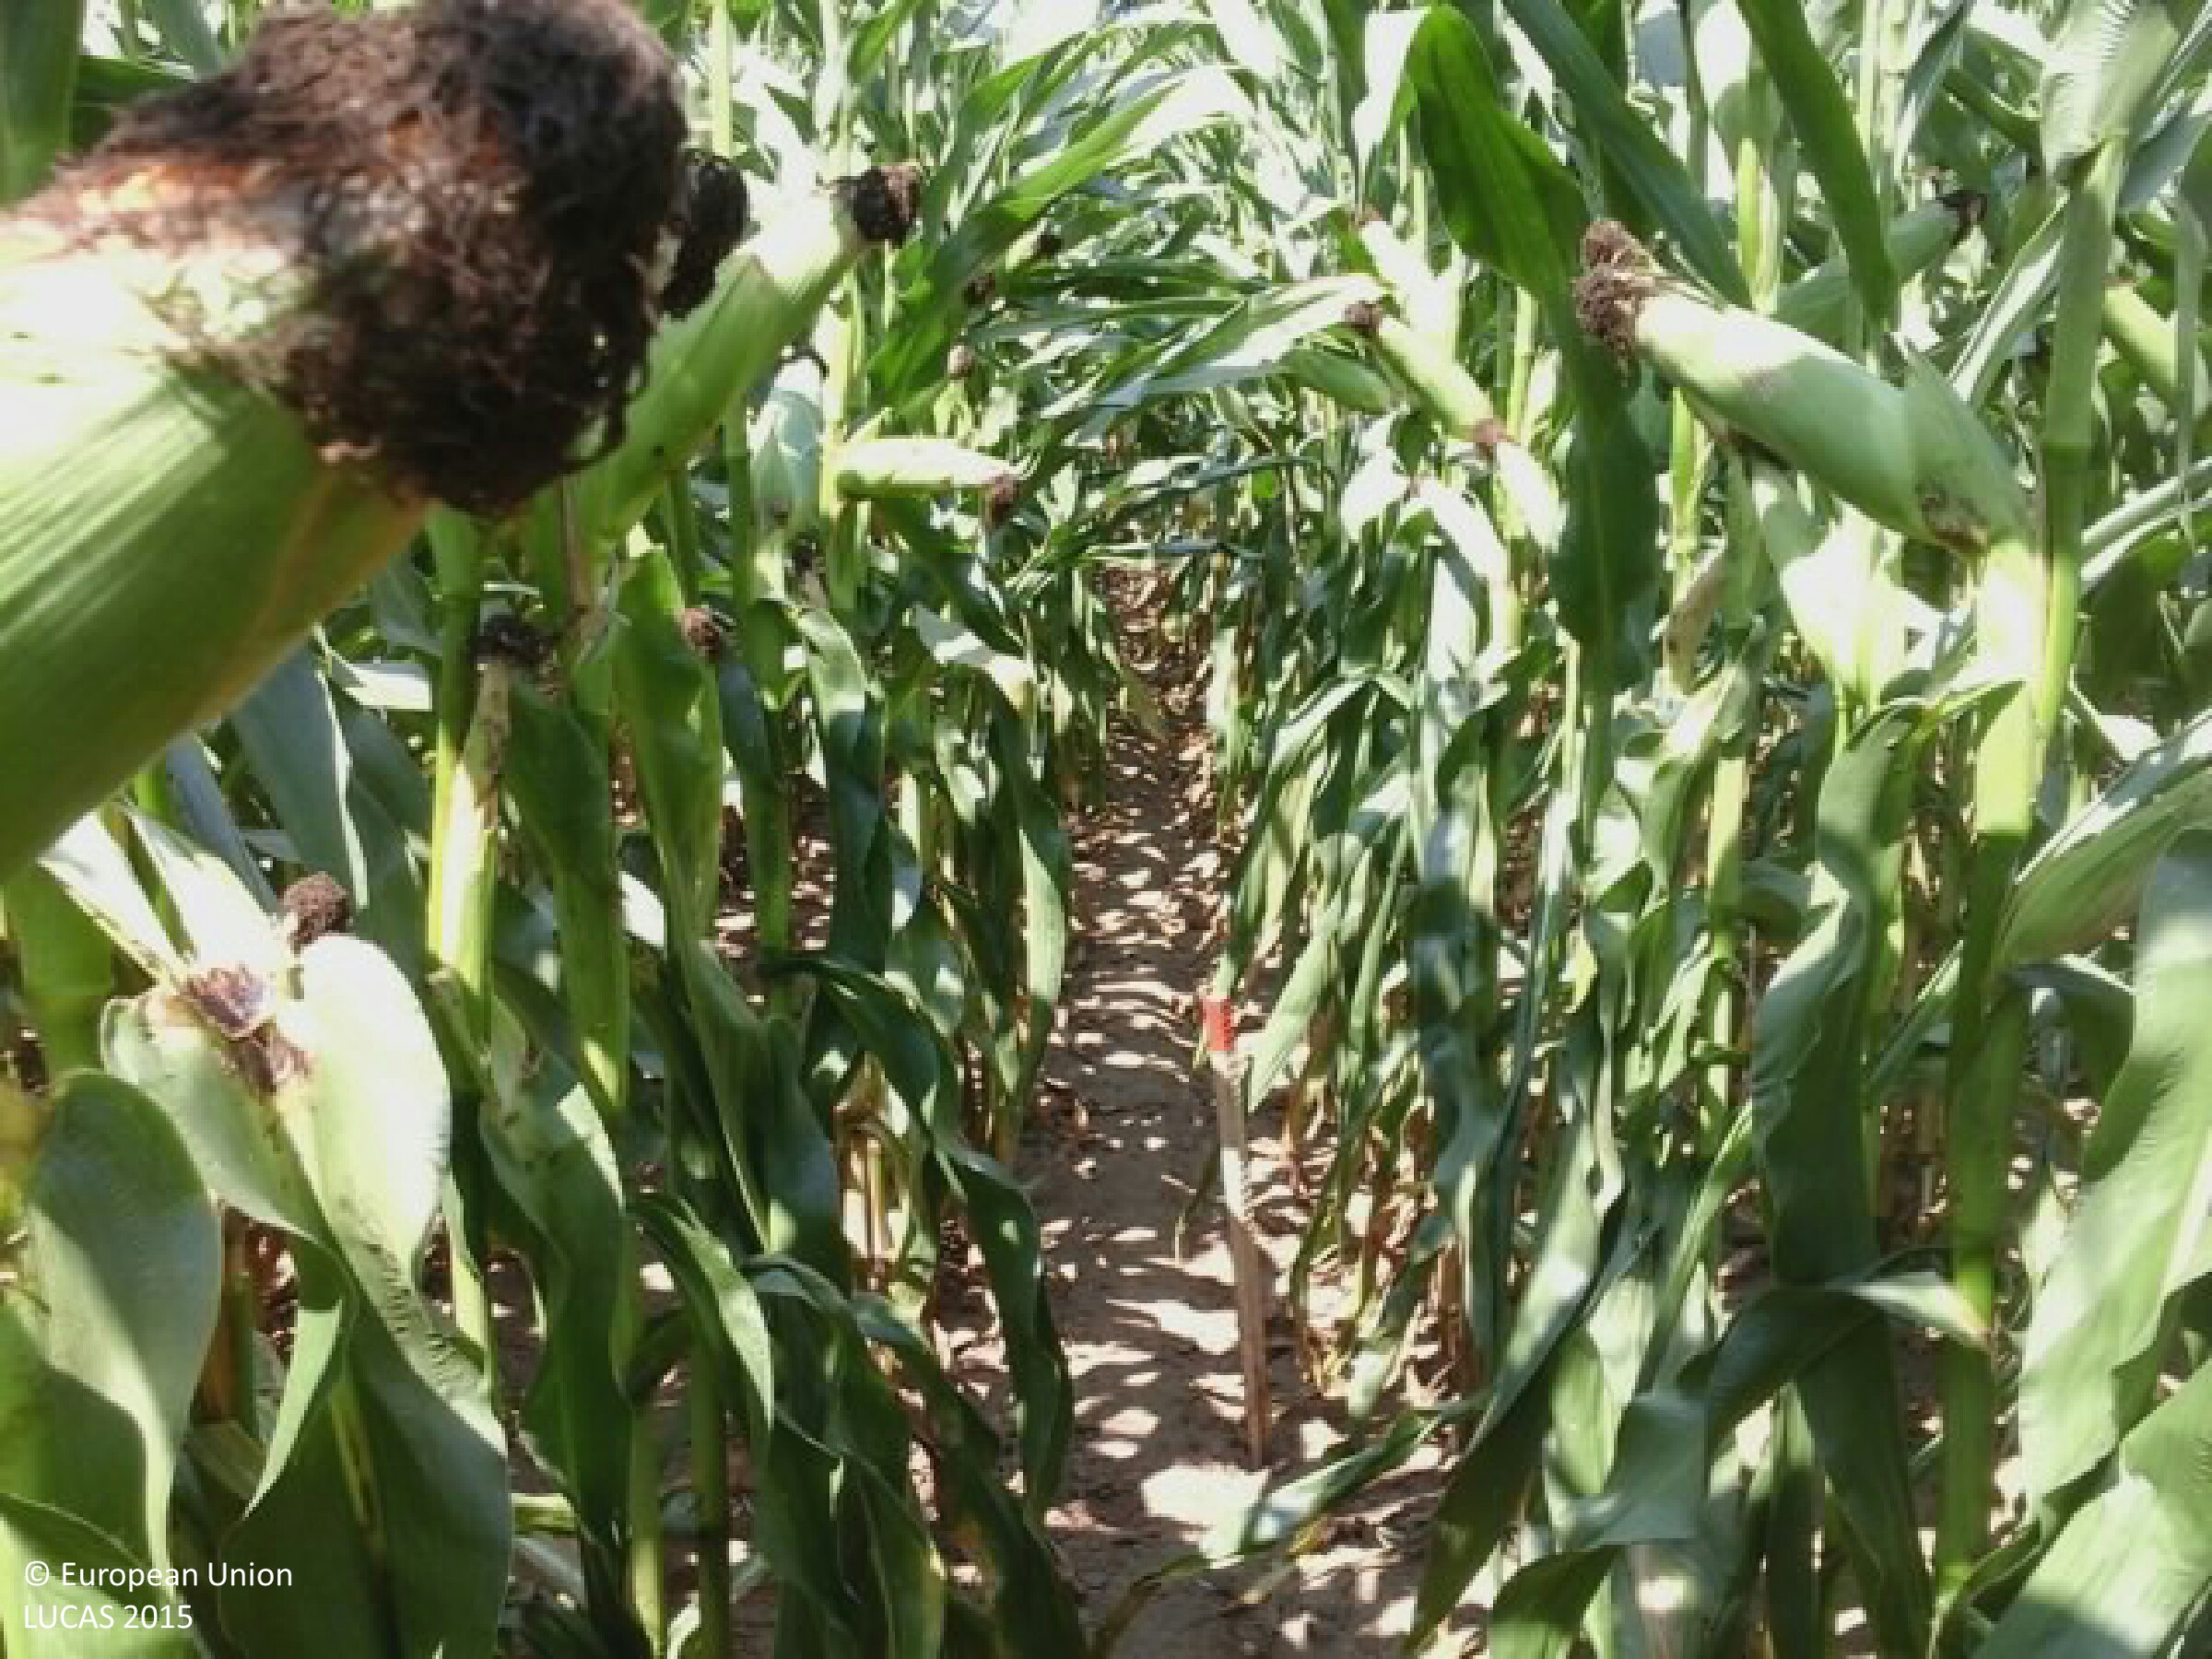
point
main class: Cropland
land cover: Maize
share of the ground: > 75 %
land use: Agriculture (excluding fallow land and kitchen gardens)
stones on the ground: < 10 %
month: August
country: HU
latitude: 46.4956
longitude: 17.8633
